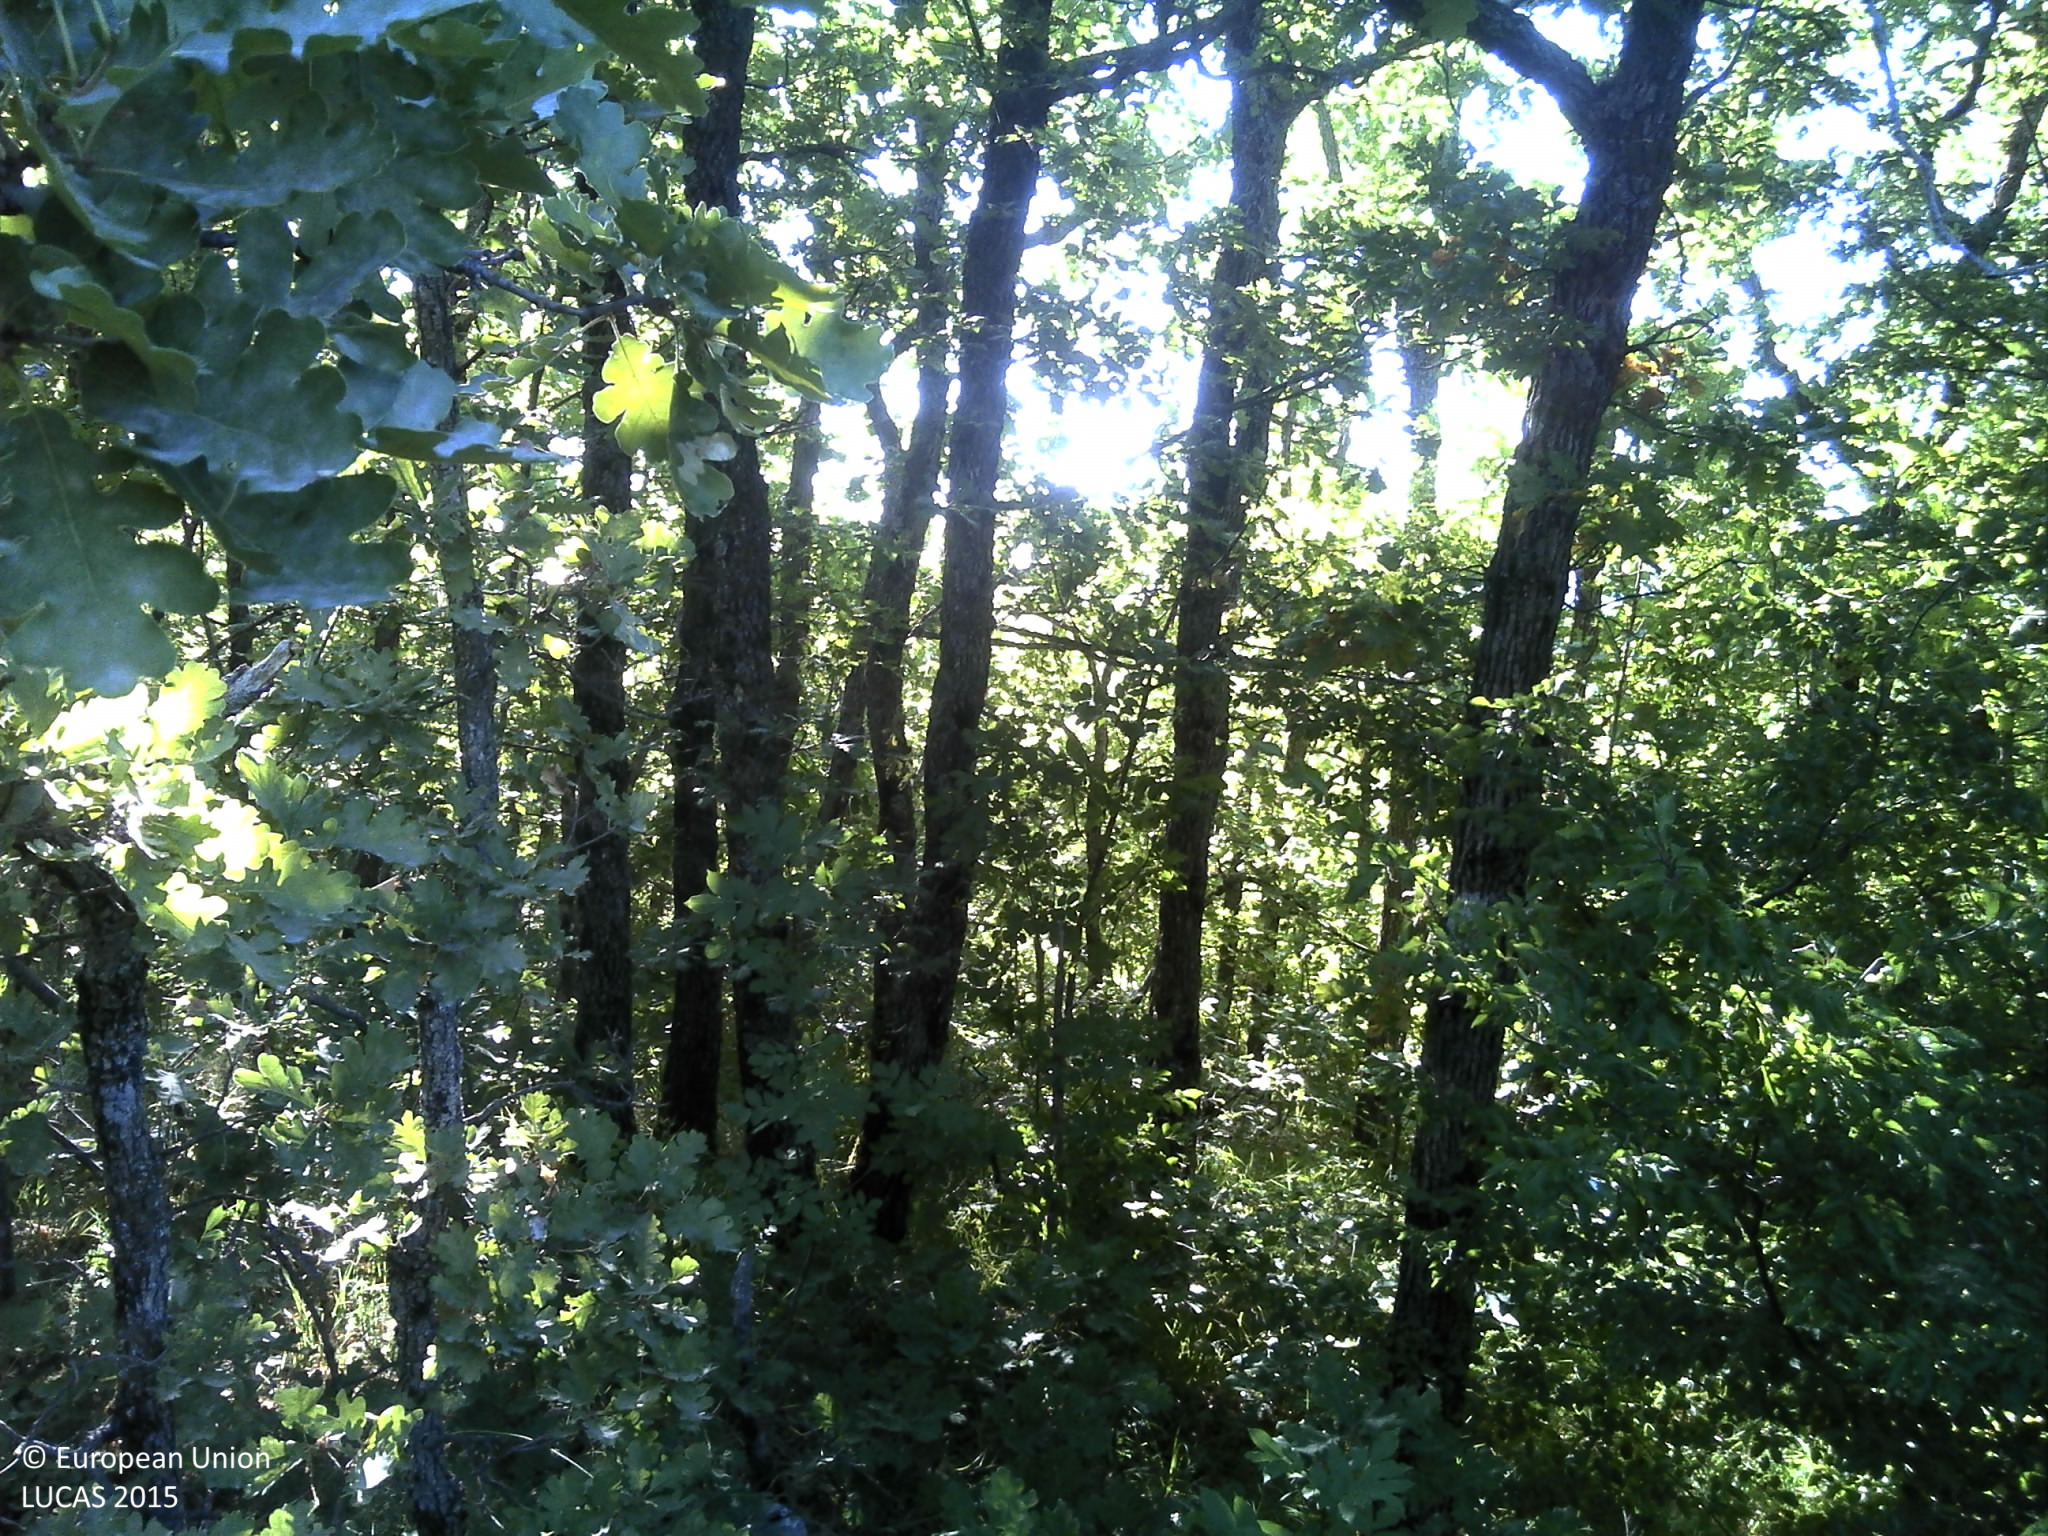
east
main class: Woodland
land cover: Other mixed woodland
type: thermophilous deciduous forest
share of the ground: > 75 %
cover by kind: broadleaved forest trees 55 %, coniferous forest trees 20 %, shrubs 10 %, herbaceous plants 10 %, consolidated bare surface 5 %
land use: Semi-natural and natural areas not in use
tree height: > 5 m
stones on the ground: < 10 %
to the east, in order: Other mixed woodland; Shrubland with sparse tree cover; Dry stone walls; Other mixed woodland; Tracks; Other mixed woodland
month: July
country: HR
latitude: 43.5392
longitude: 16.9344
